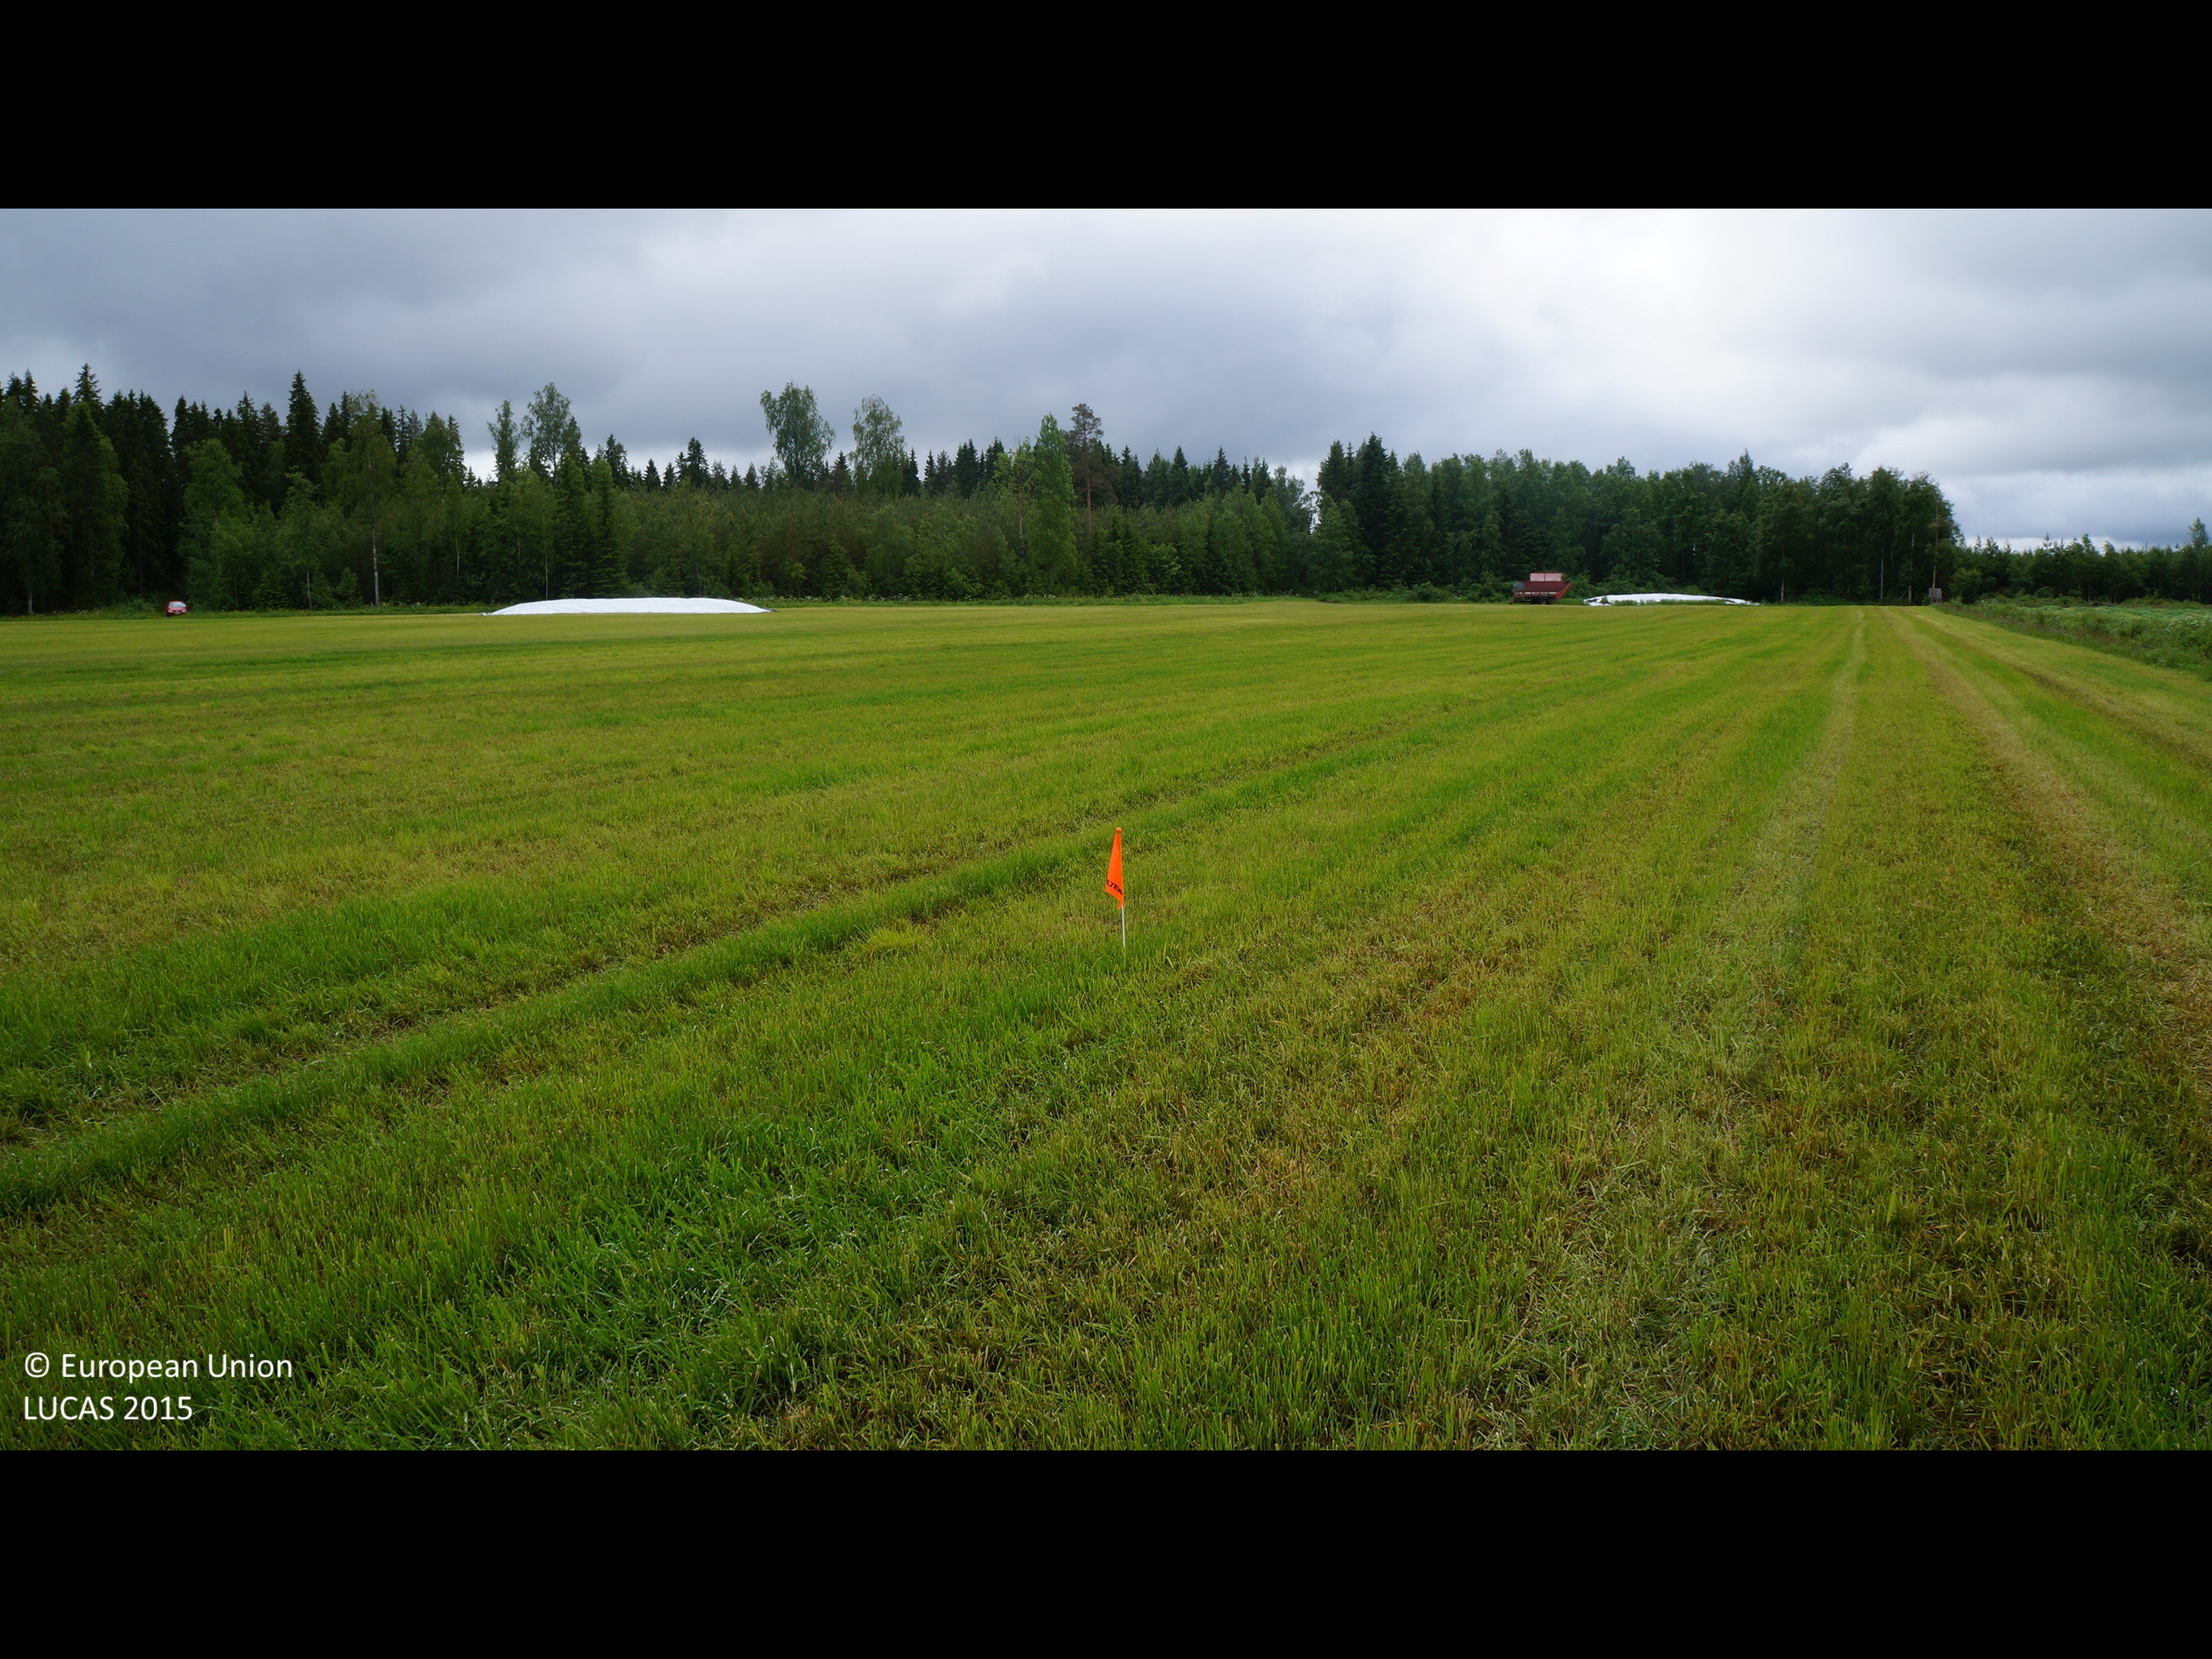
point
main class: Cropland
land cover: Temporary grasslands
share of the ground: > 75 %
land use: Agriculture (excluding fallow land and kitchen gardens)
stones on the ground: < 10 %
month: June
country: FI
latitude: 63.7161
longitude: 23.1913
